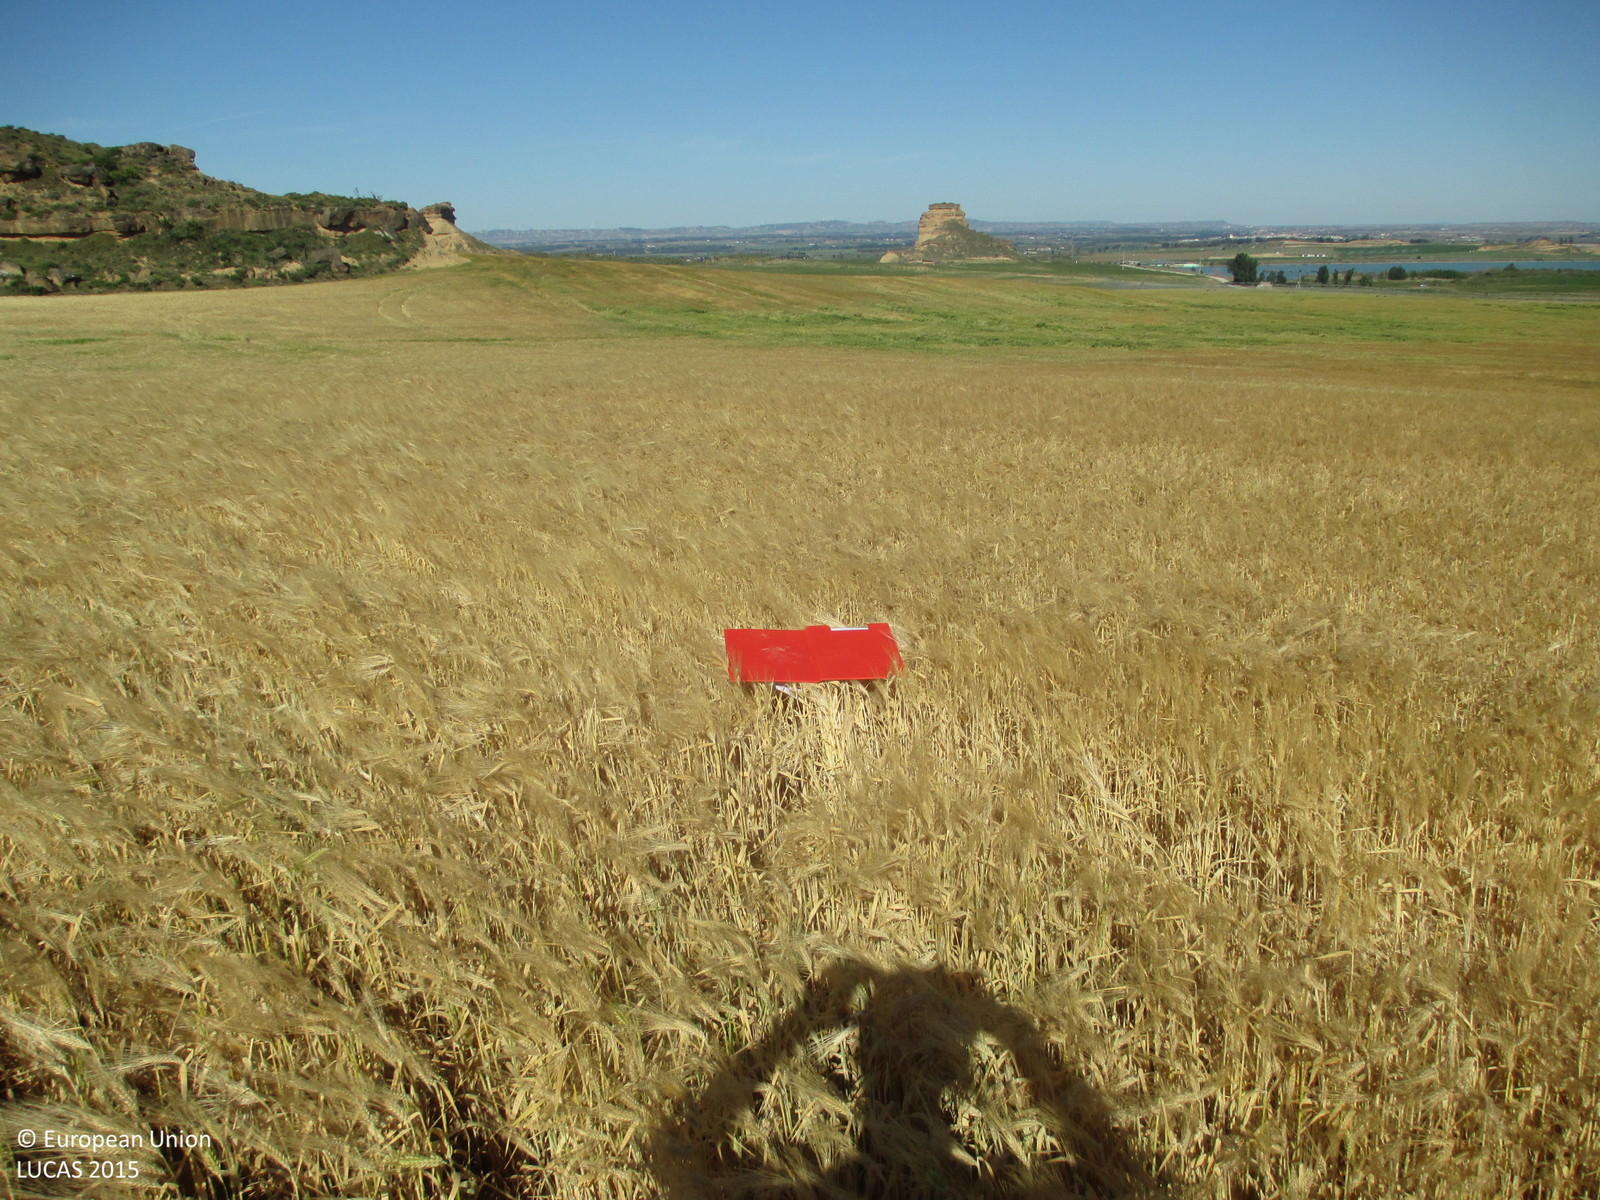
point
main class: Cropland
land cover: Barley
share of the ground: > 75 %
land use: Agriculture (excluding fallow land and kitchen gardens)
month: May
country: ES
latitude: 41.9138
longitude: -0.2556
